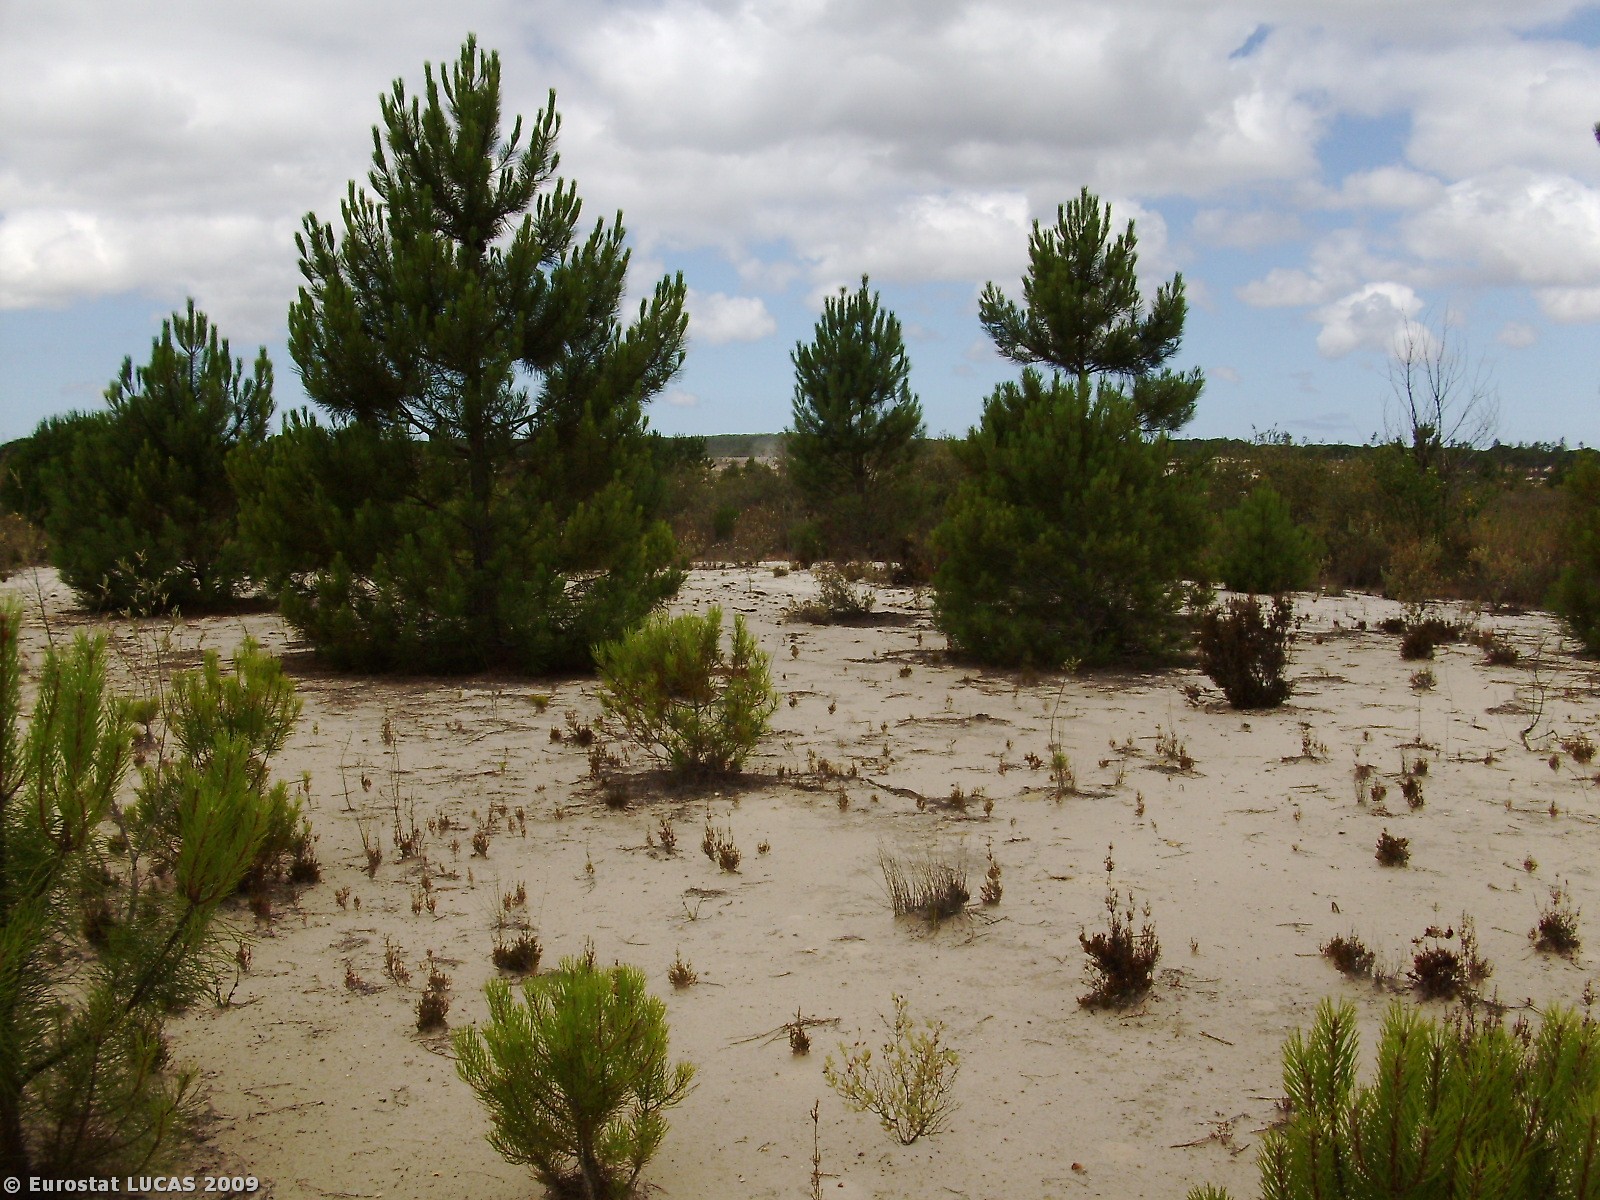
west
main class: Woodland
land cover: Coniferous woodland
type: coniferous forest of the mediterranean region
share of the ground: 25 - 50 %
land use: Forestry
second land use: Mining and quarrying
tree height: > 5 m
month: June
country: PT
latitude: 38.2625
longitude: -8.5296
